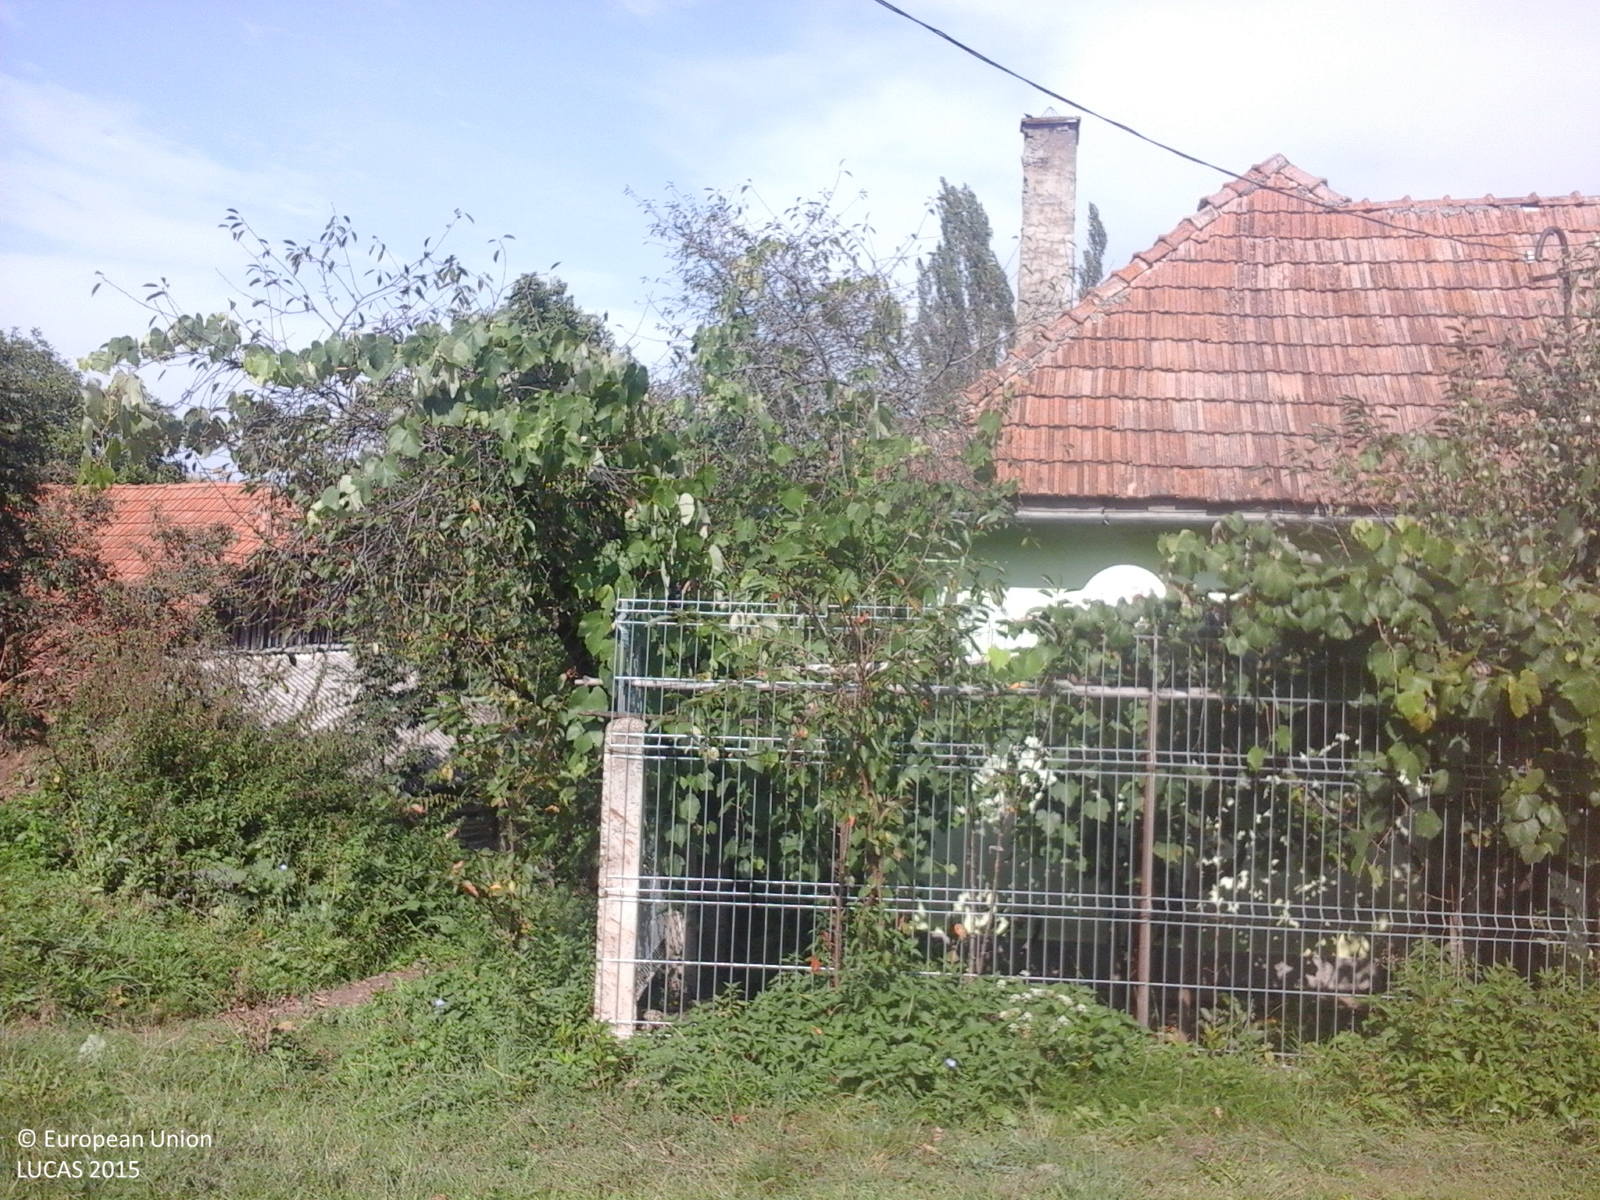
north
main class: Cropland
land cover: Apple fruit
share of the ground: > 75 %
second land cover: Grassland without tree/shrub cover
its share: > 75 %
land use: Agriculture (excluding fallow land and kitchen gardens)
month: September
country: RO
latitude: 46.8079
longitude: 23.1815
